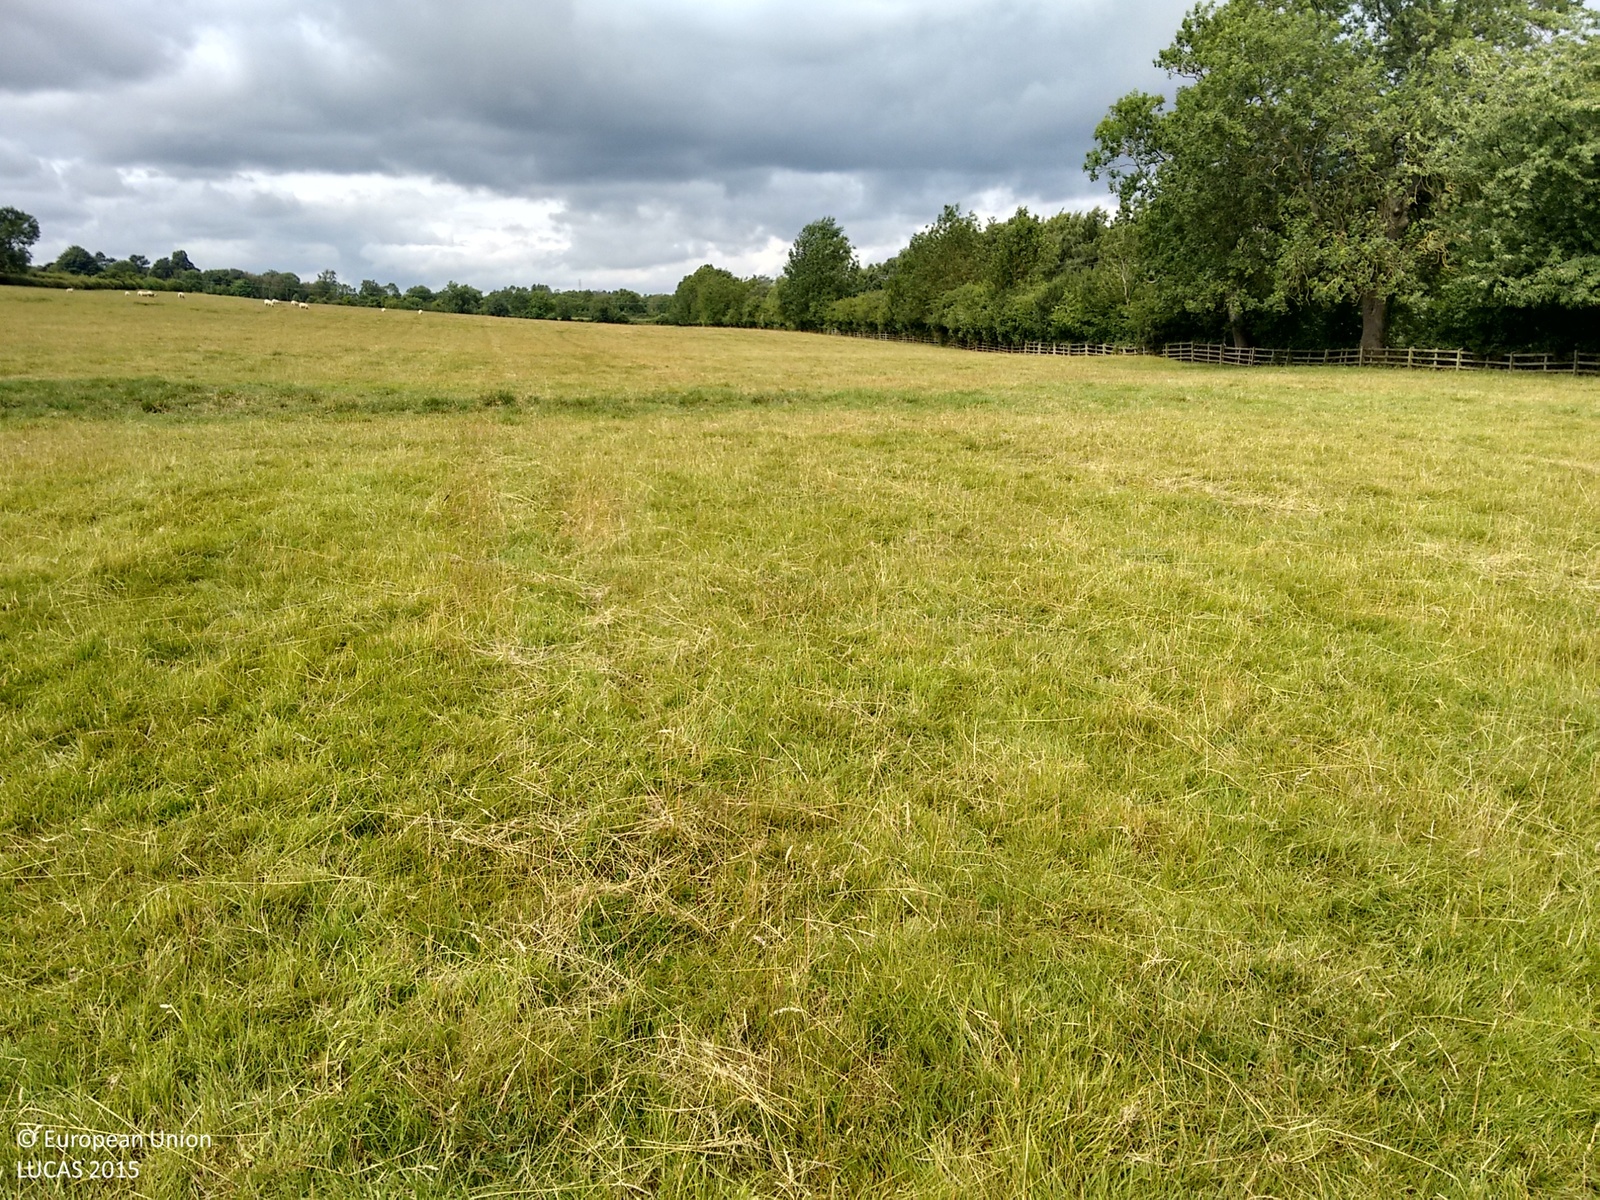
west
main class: Grassland
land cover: Grassland without tree/shrub cover
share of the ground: > 75 %
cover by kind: herbaceous plants 100 %
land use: Agriculture (excluding fallow land and kitchen gardens)
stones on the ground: < 10 %
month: July
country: GB
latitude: 52.6367
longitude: -0.6943
